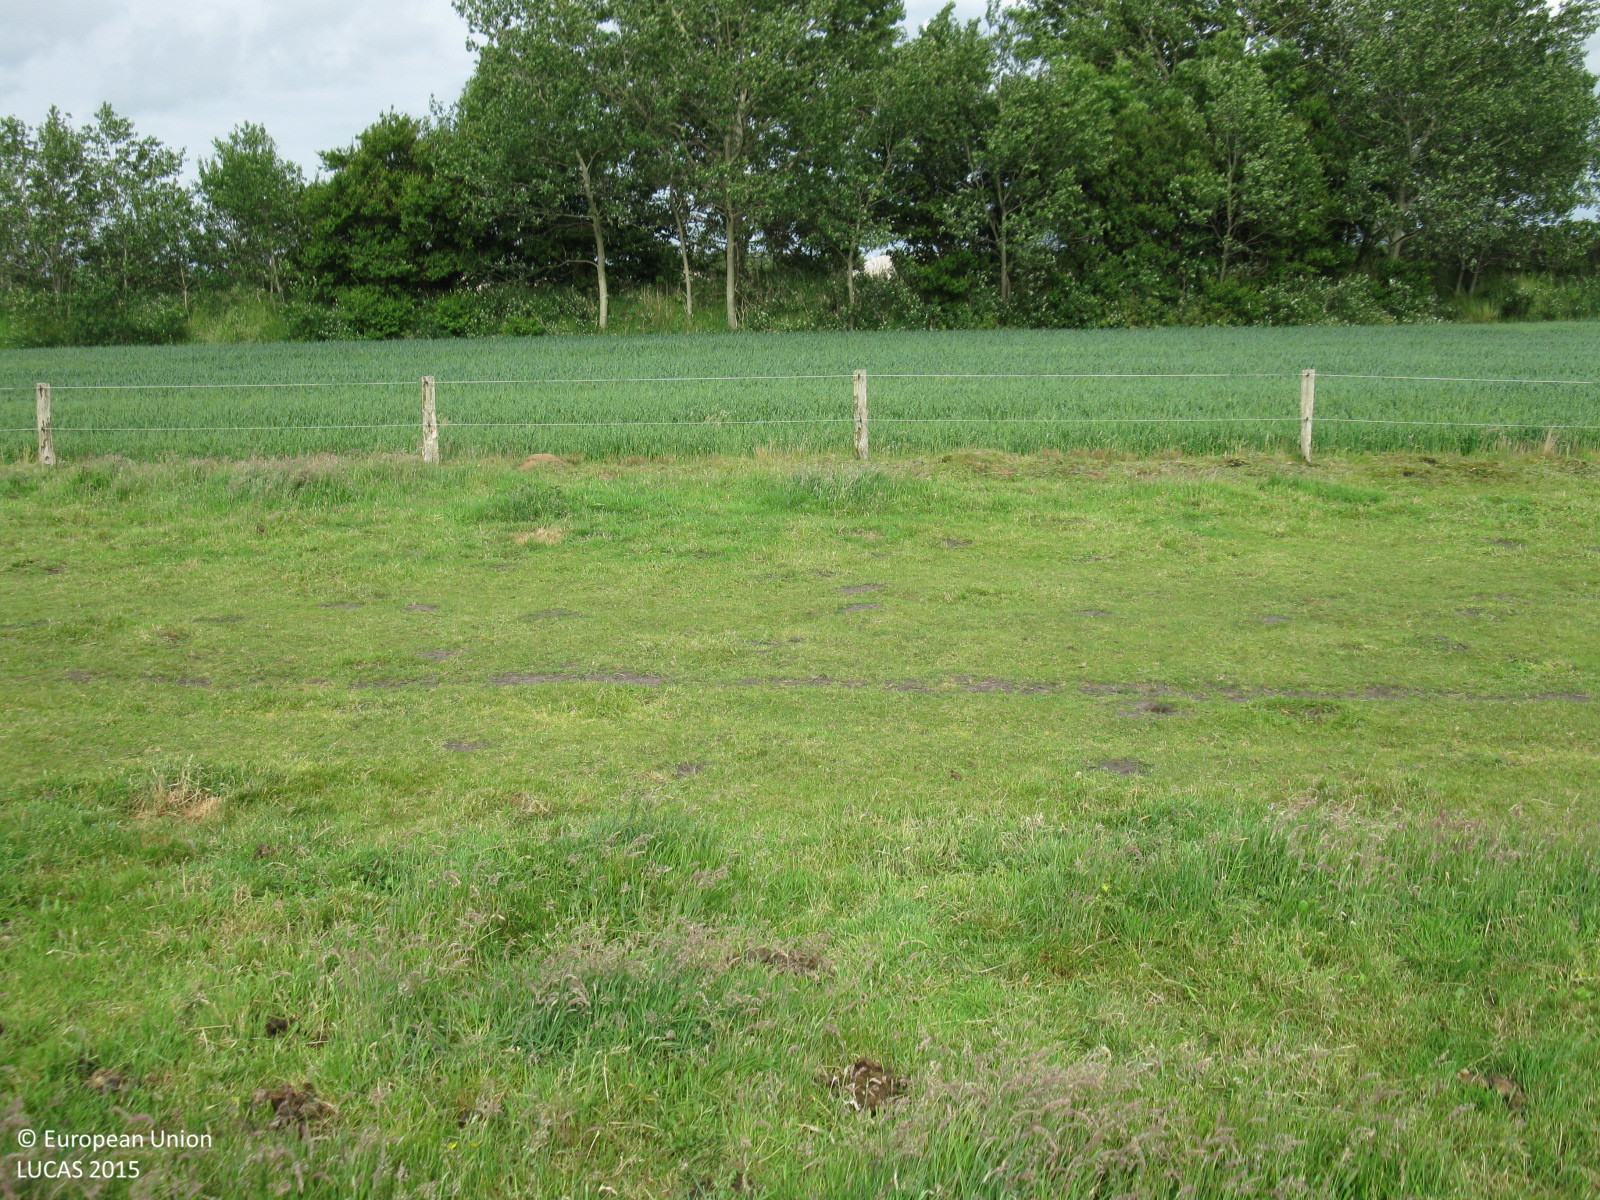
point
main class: Grassland
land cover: Grassland without tree/shrub cover
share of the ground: > 75 %
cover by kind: herbaceous plants 100 %
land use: Agriculture (excluding fallow land and kitchen gardens)
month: June
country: DE
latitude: 53.6069
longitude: 7.3558
